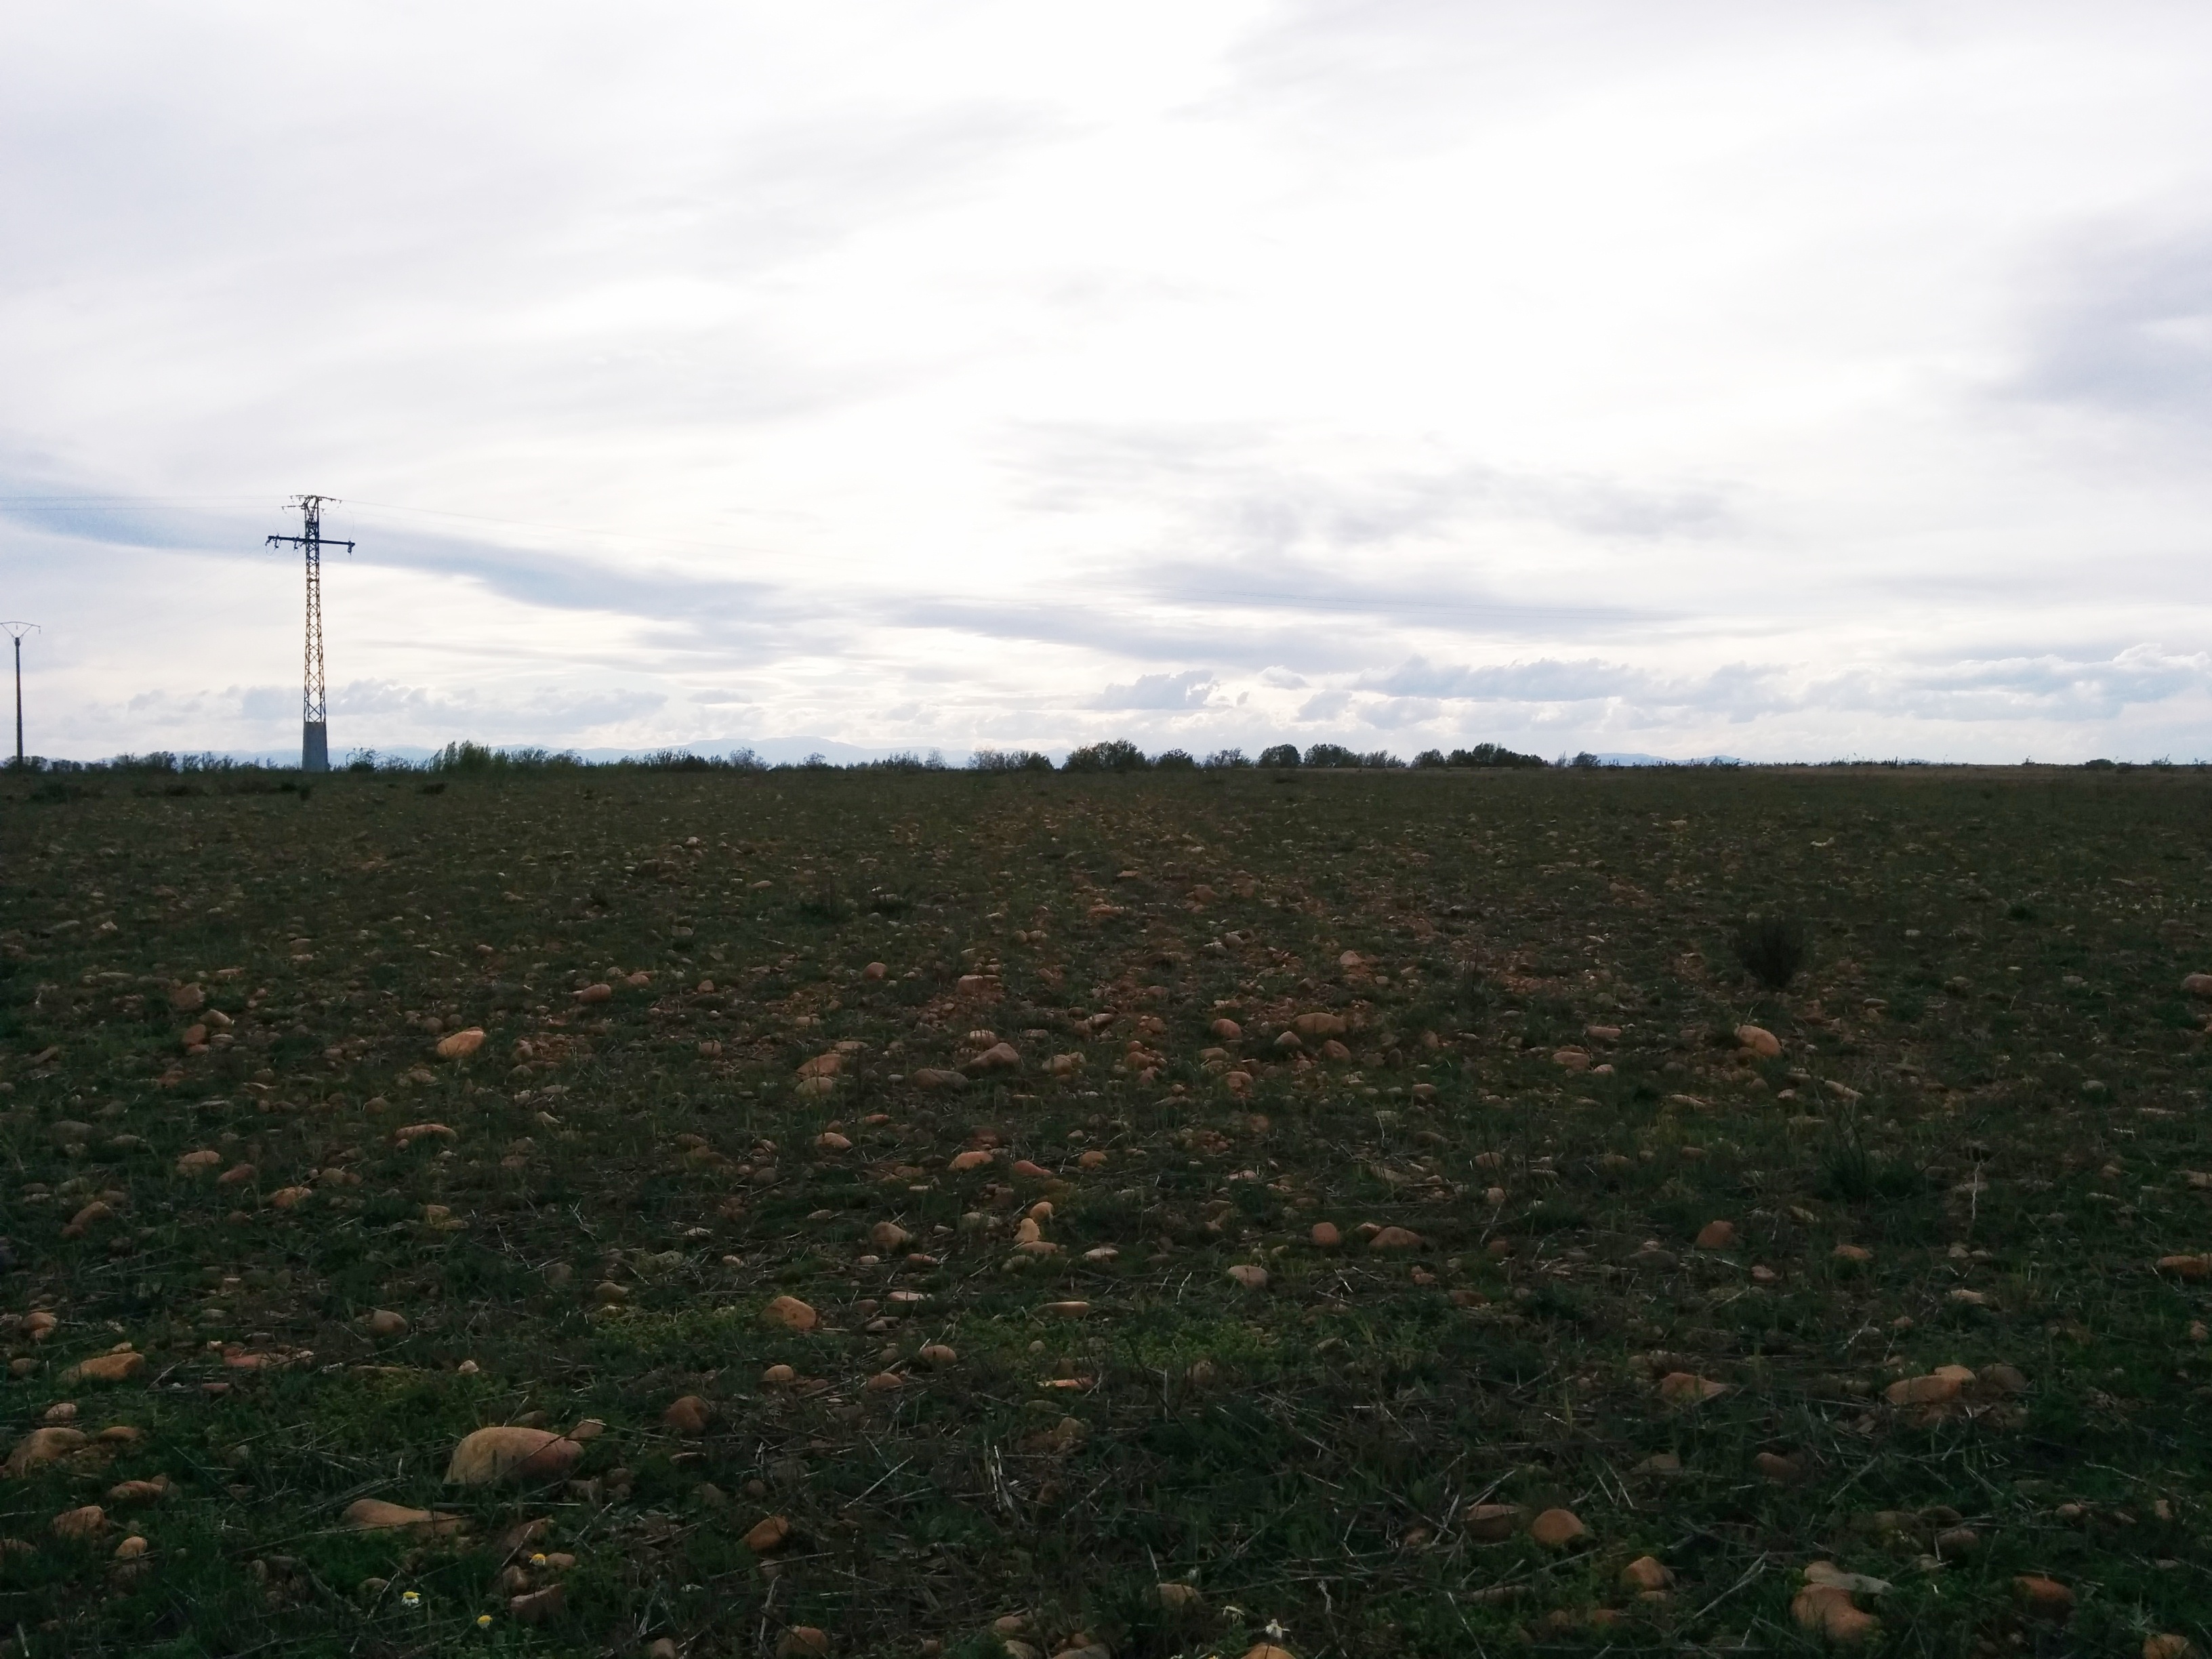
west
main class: Grassland
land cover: Grassland without tree/shrub cover
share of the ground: 25 - 50 %
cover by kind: unconsolidated bare surface 55 %, herbaceous plants 25 %, consolidated bare surface 15 %, shrubs 5 %
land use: Agriculture (excluding fallow land and kitchen gardens)
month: April
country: ES
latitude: 42.4670
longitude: -5.7023
